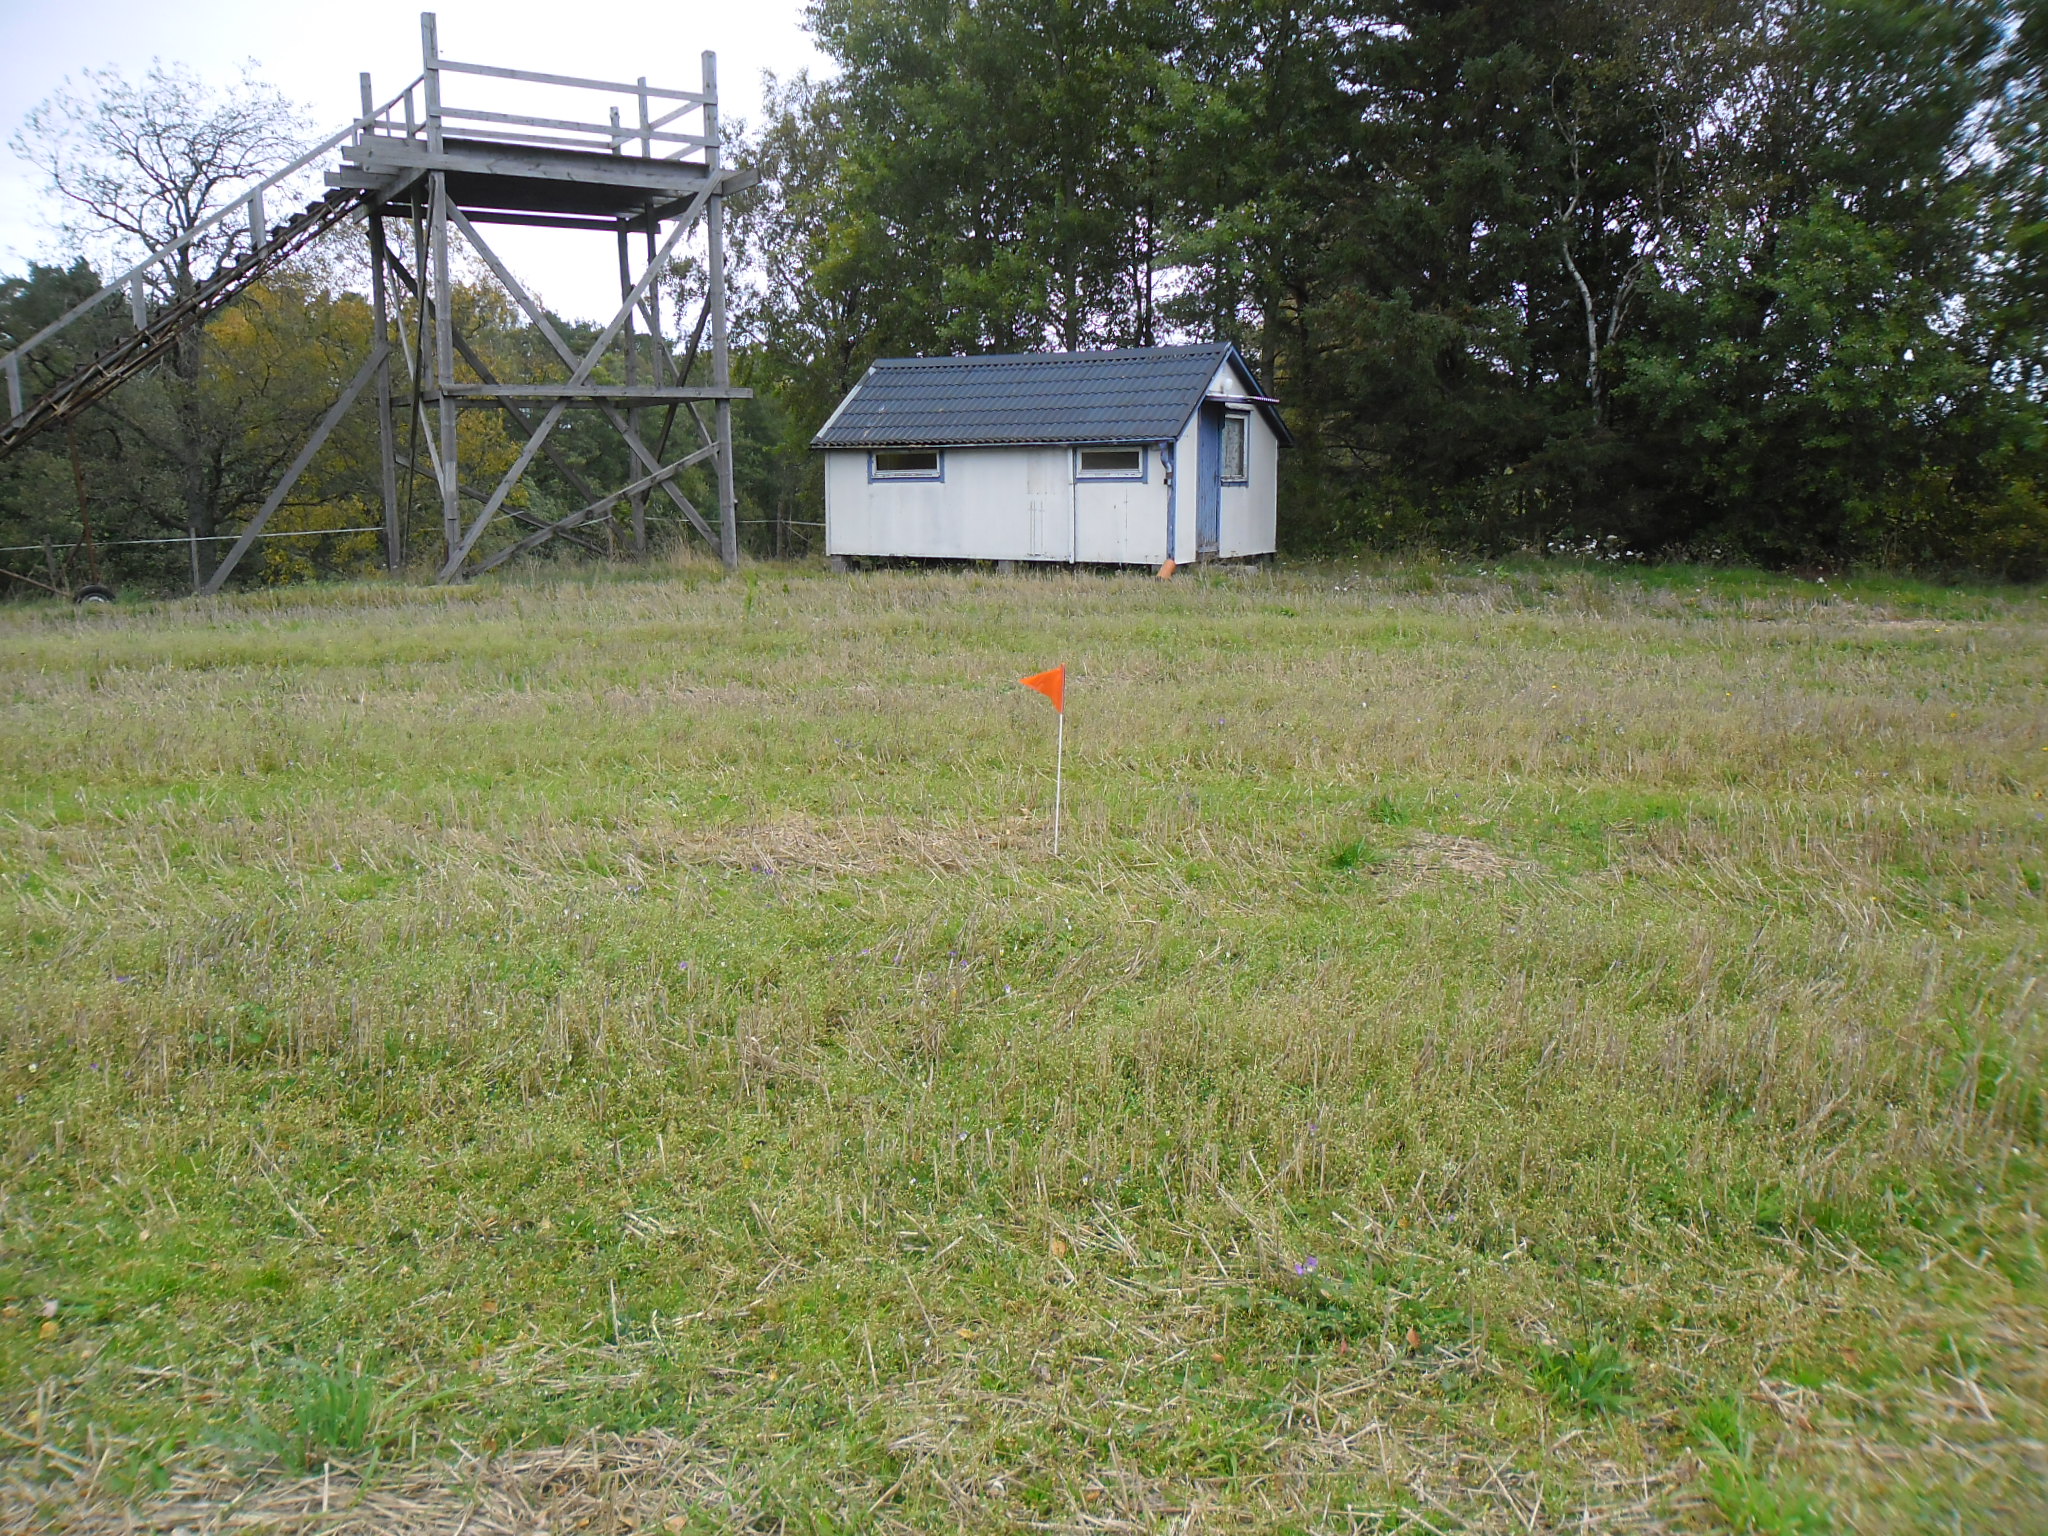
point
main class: Cropland
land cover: Common wheat
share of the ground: < 10 %
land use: Agriculture (excluding fallow land and kitchen gardens)
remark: Harvested field
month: October
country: SE
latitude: 56.5812
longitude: 13.1390
